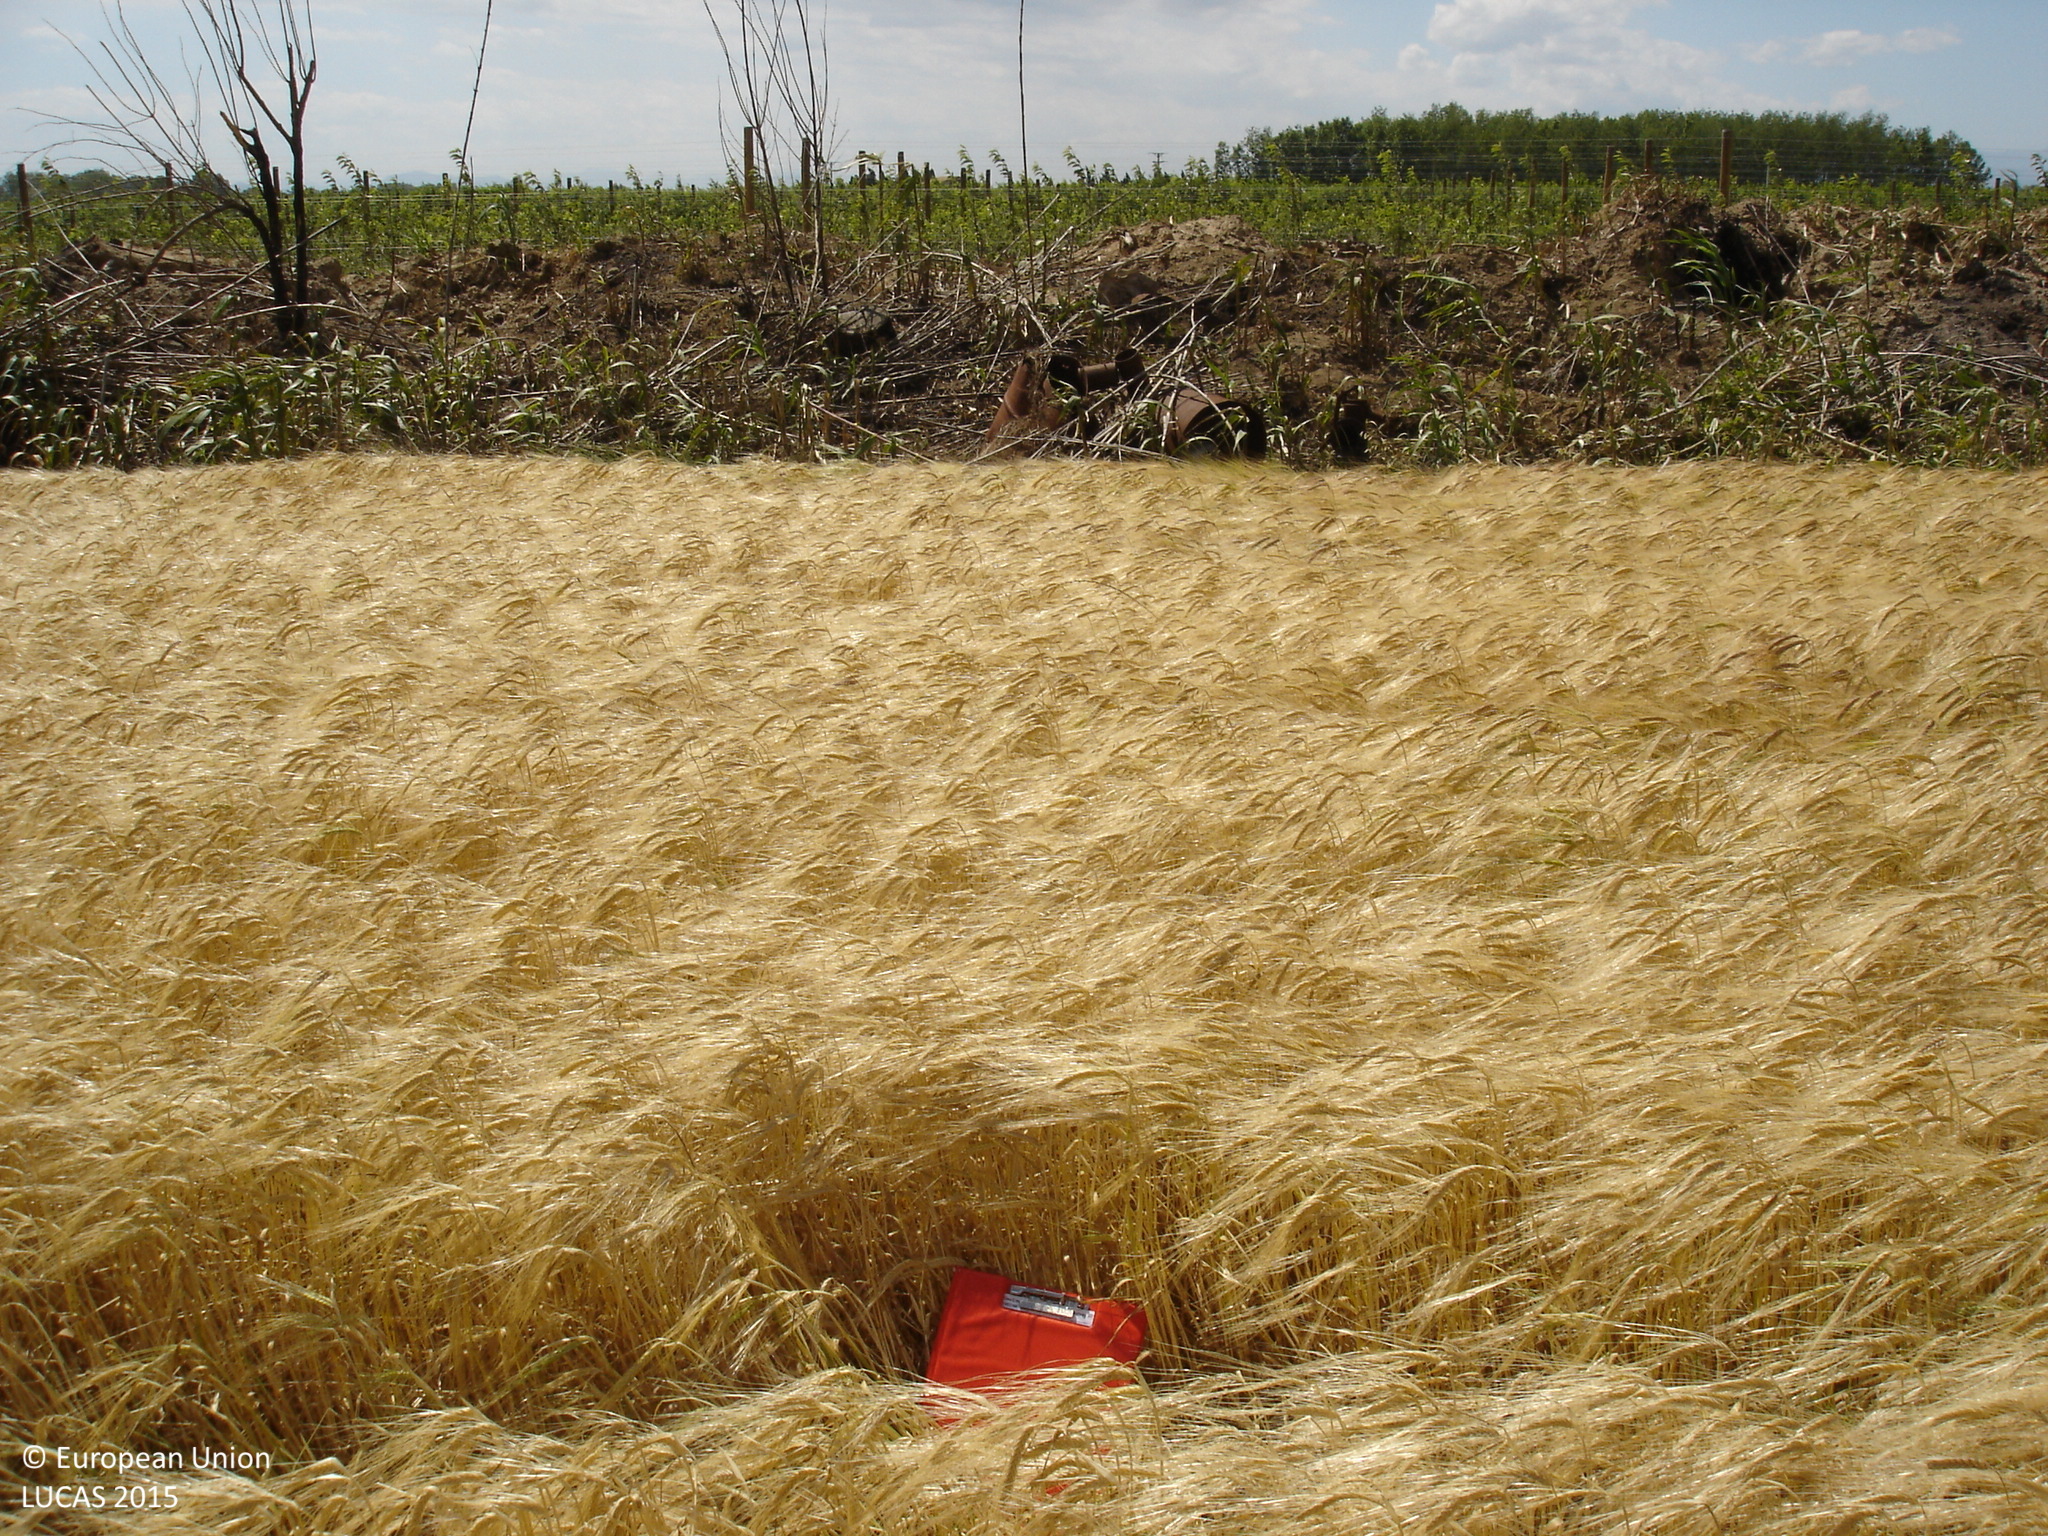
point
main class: Cropland
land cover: Barley
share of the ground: > 75 %
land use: Agriculture (excluding fallow land and kitchen gardens)
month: May
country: ES
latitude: 42.1814
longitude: 3.0773
